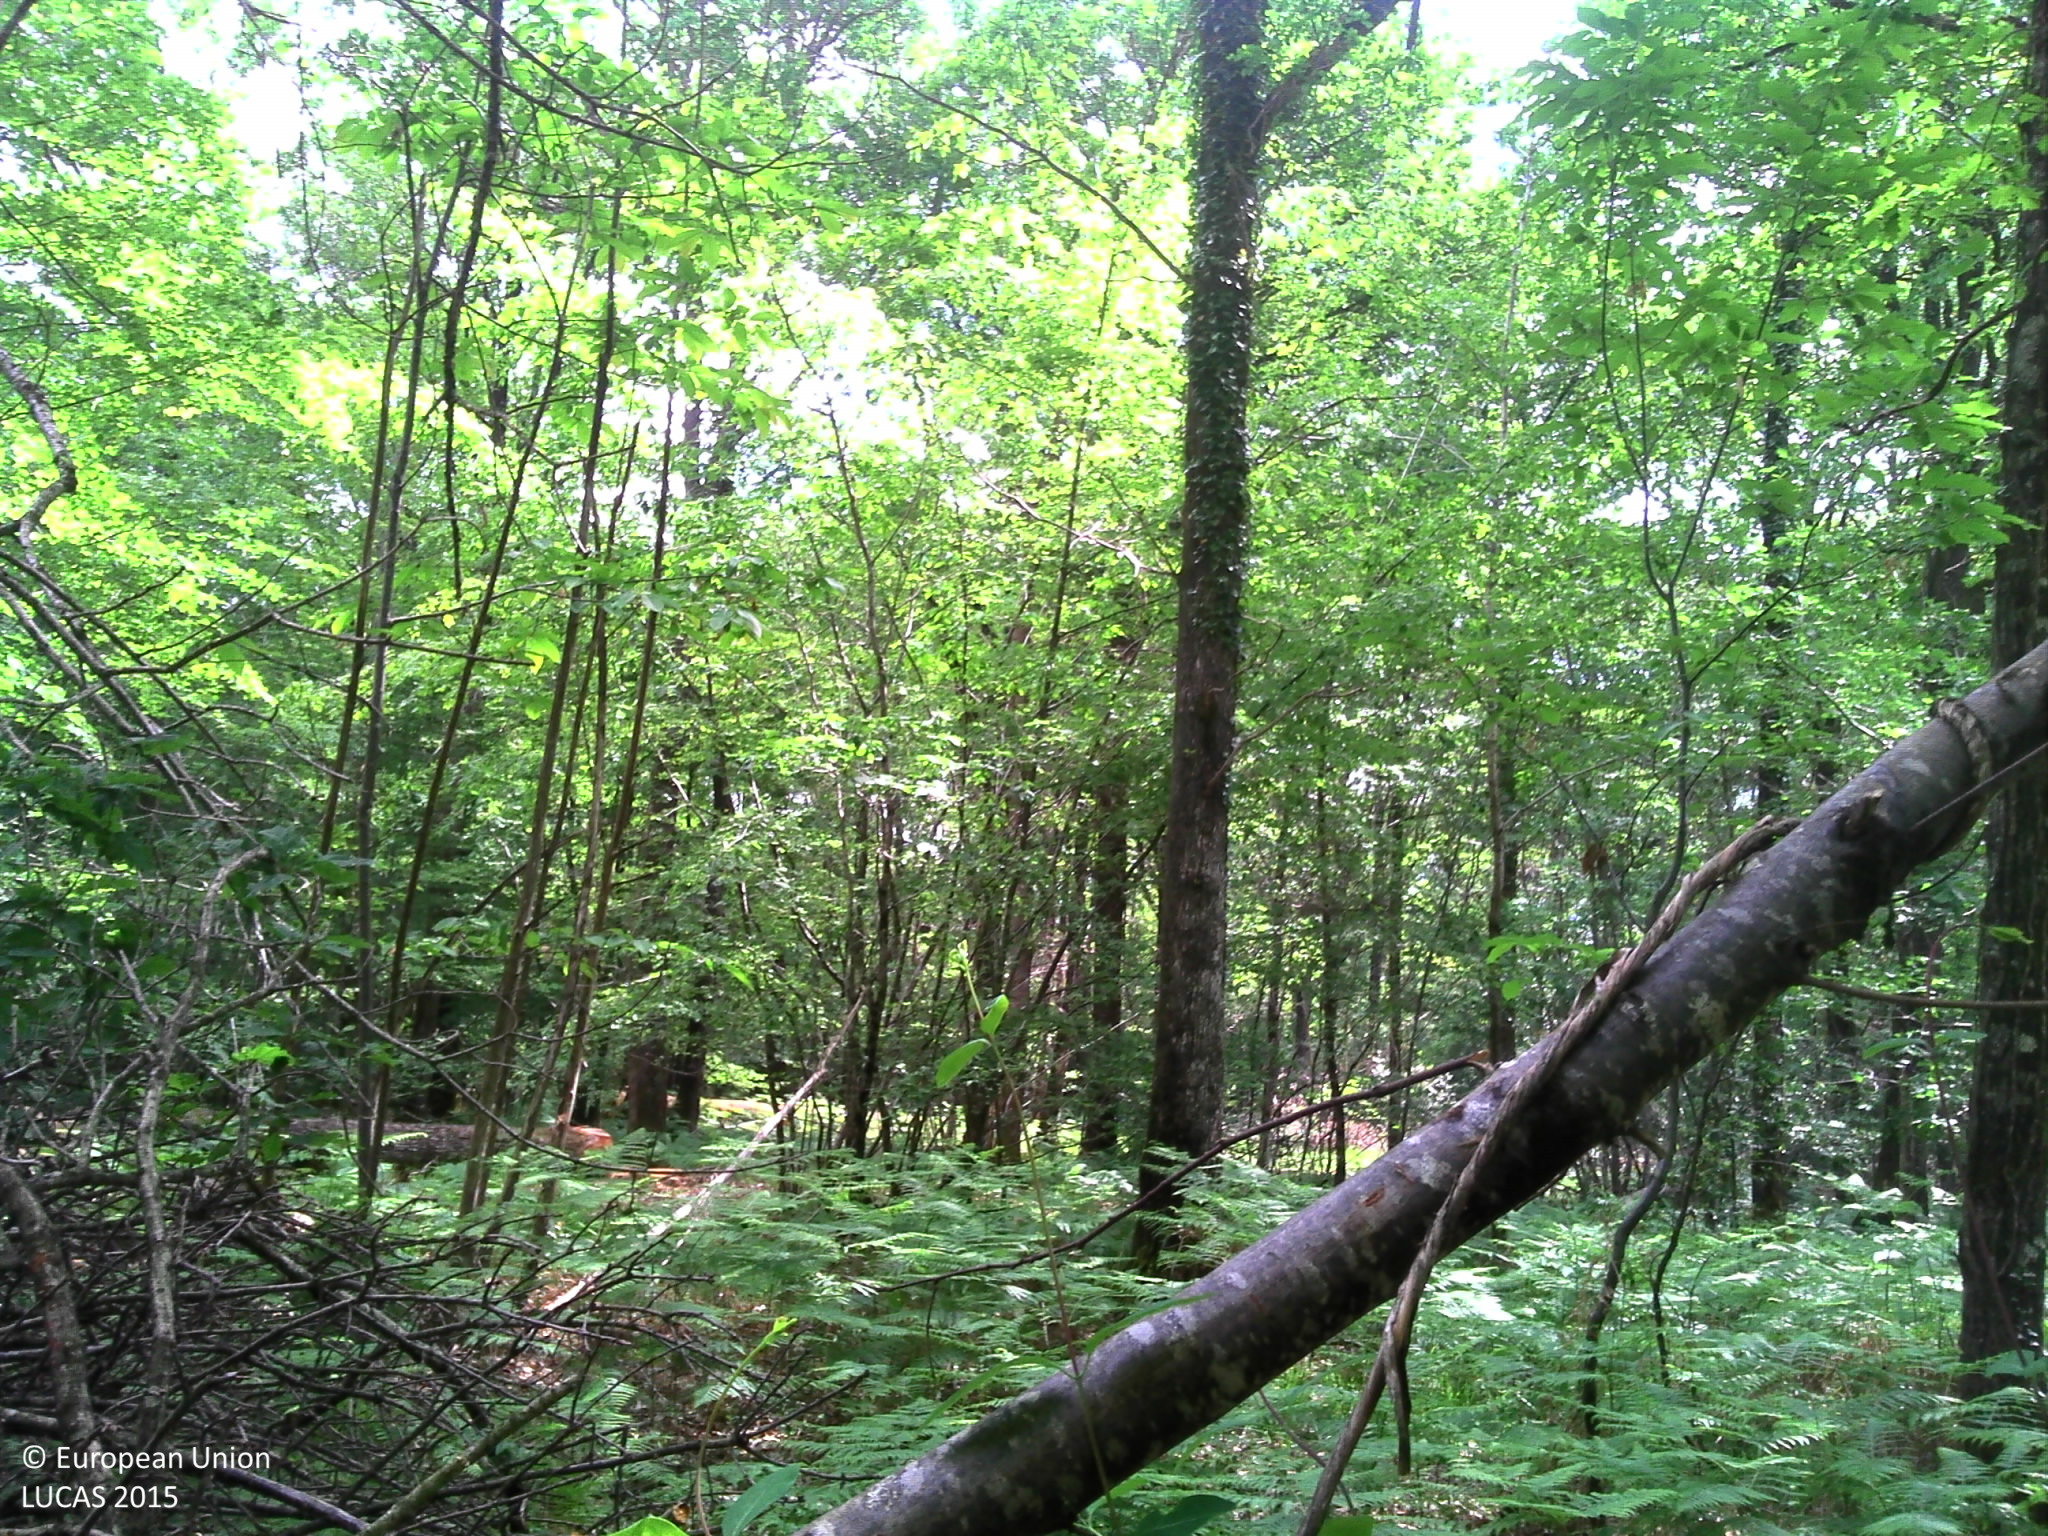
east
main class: Woodland
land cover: Broadleaved woodland
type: mesophytic deciduous forest
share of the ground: > 75 %
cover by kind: broadleaved forest trees 75 %, herbaceous plants 20 %, lichens and mosses 5 %
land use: Forestry
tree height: > 5 m
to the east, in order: Broadleaved woodland; Grass margins; Tracks; Grass margins; Common wheat
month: May
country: FR
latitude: 47.6888
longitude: 0.7471
